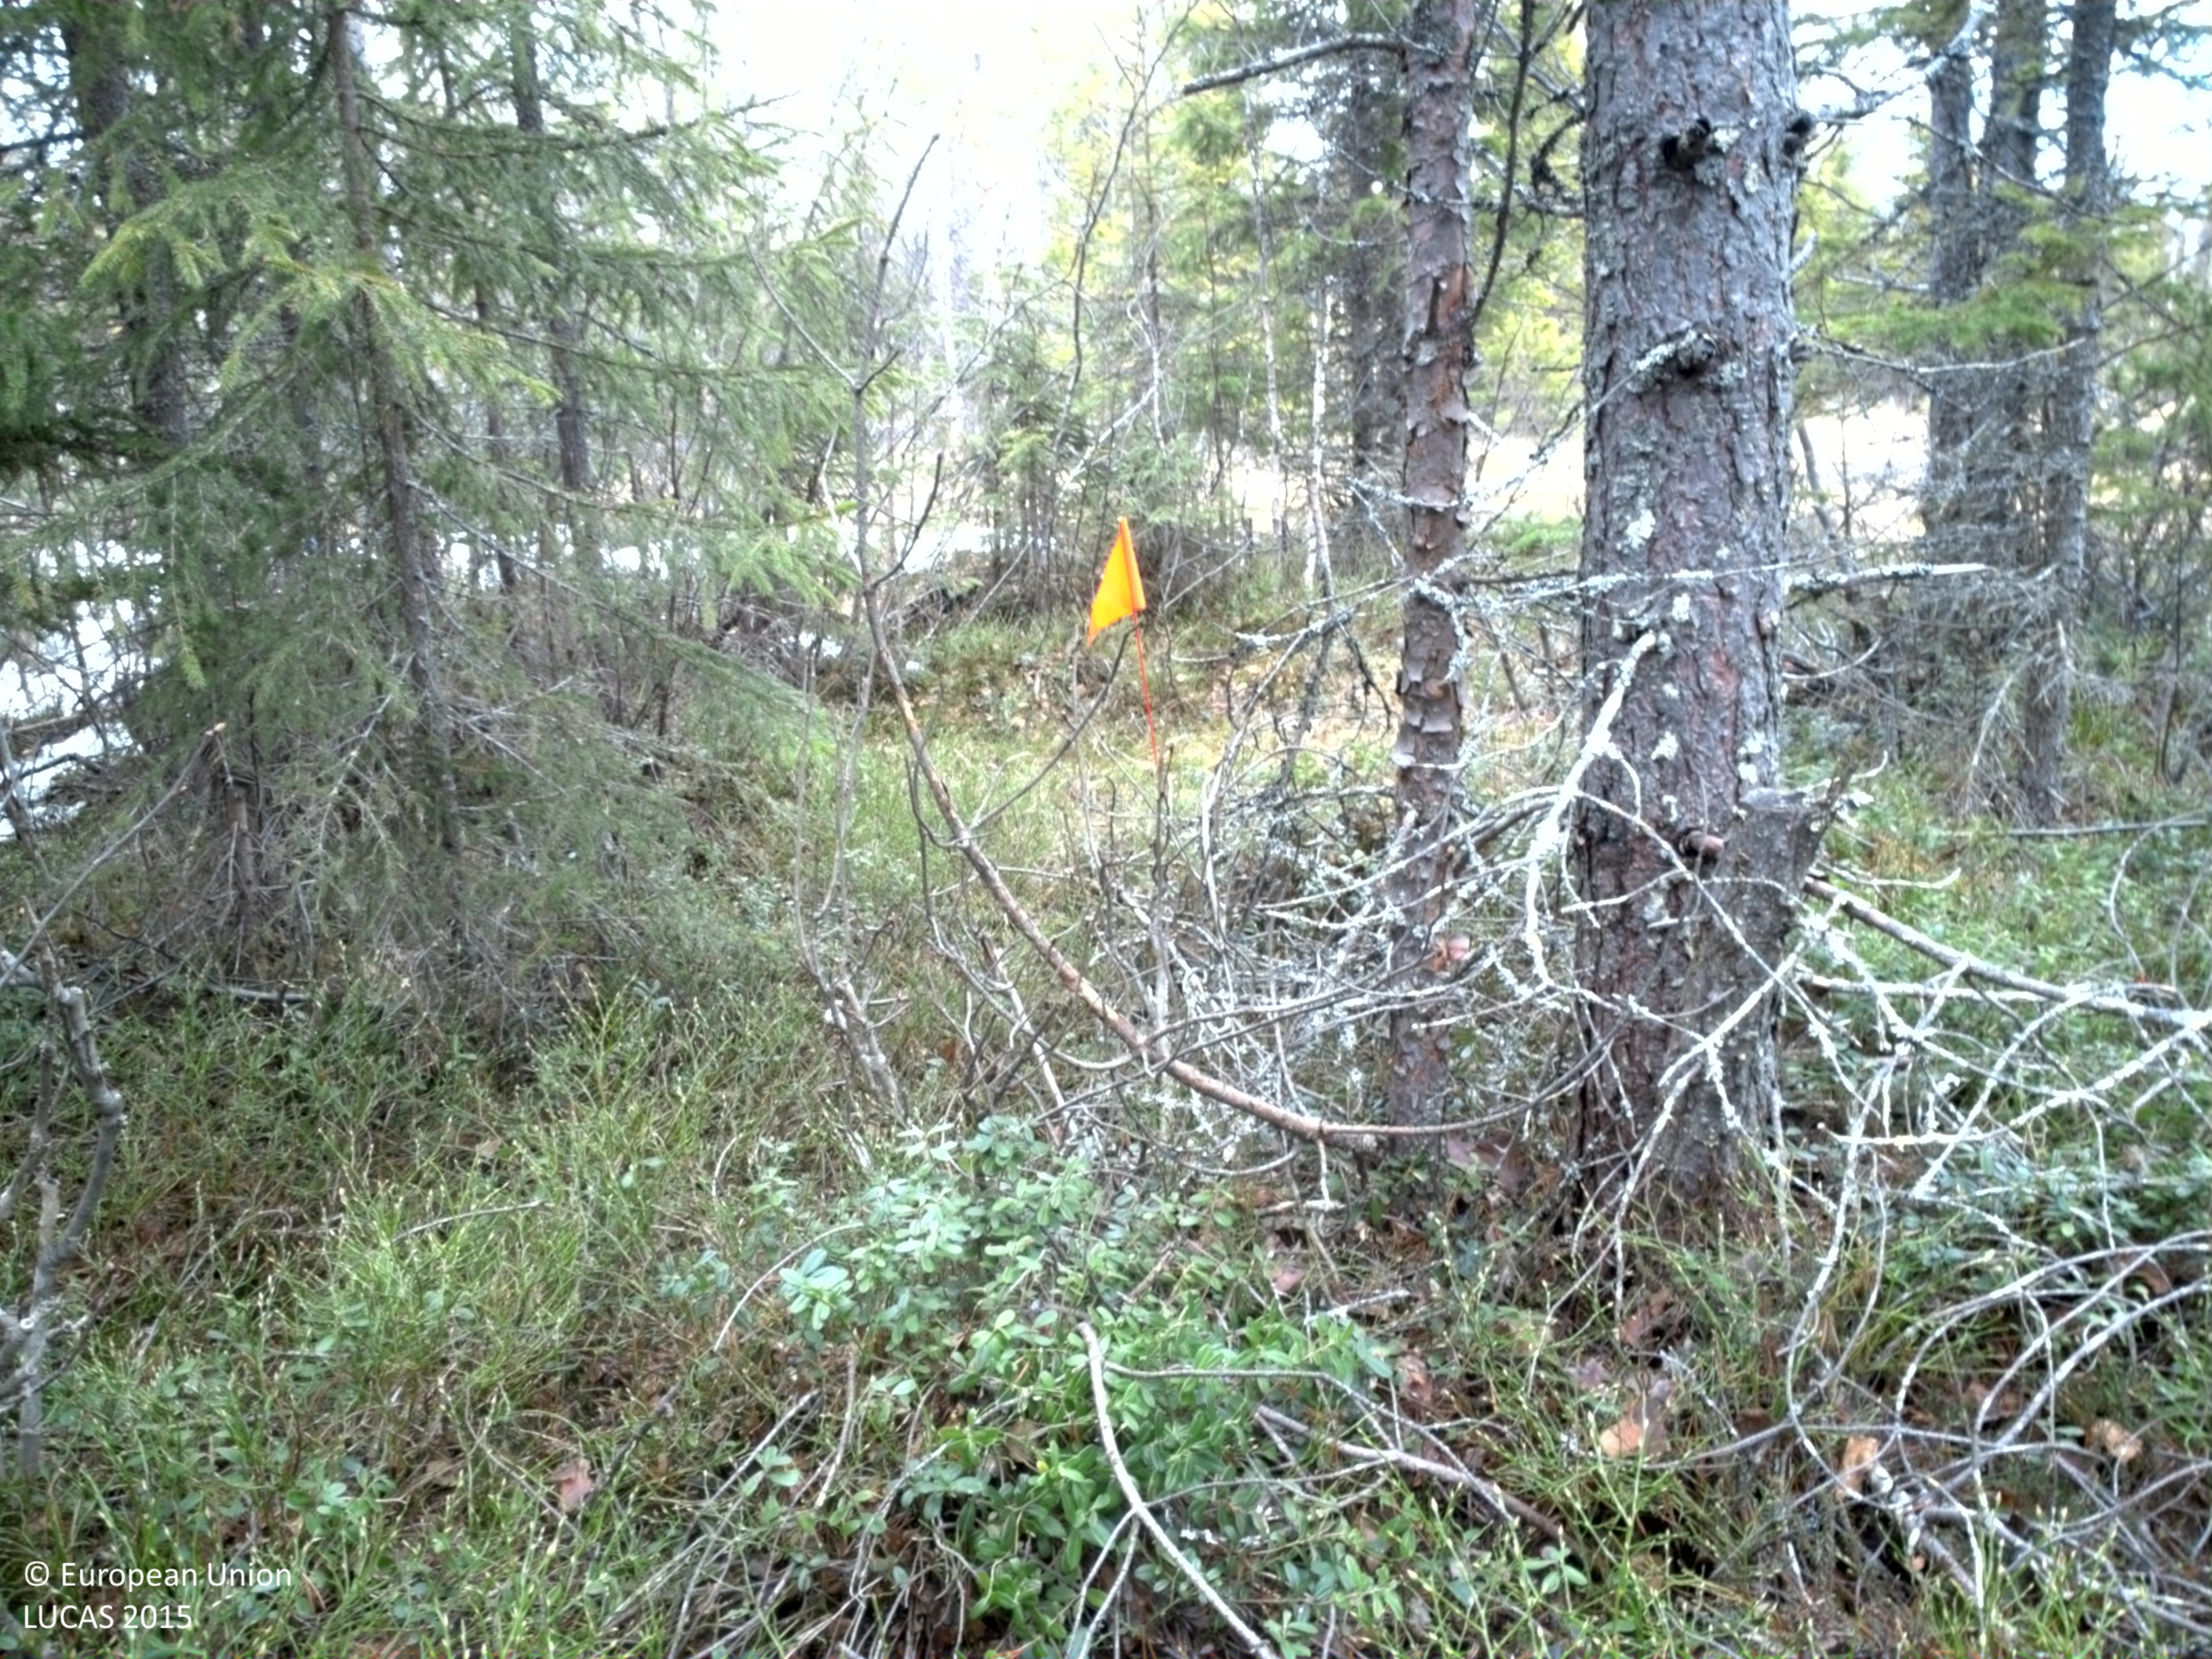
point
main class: Woodland
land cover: Other coniferous woodland
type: boreal forest
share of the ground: > 75 %
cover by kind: coniferous forest trees 75 %, shrubs 20 %, broadleaved forest trees 5 %
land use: Forestry
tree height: > 5 m
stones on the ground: < 10 %
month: May
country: SE
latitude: 66.1662
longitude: 23.8100
